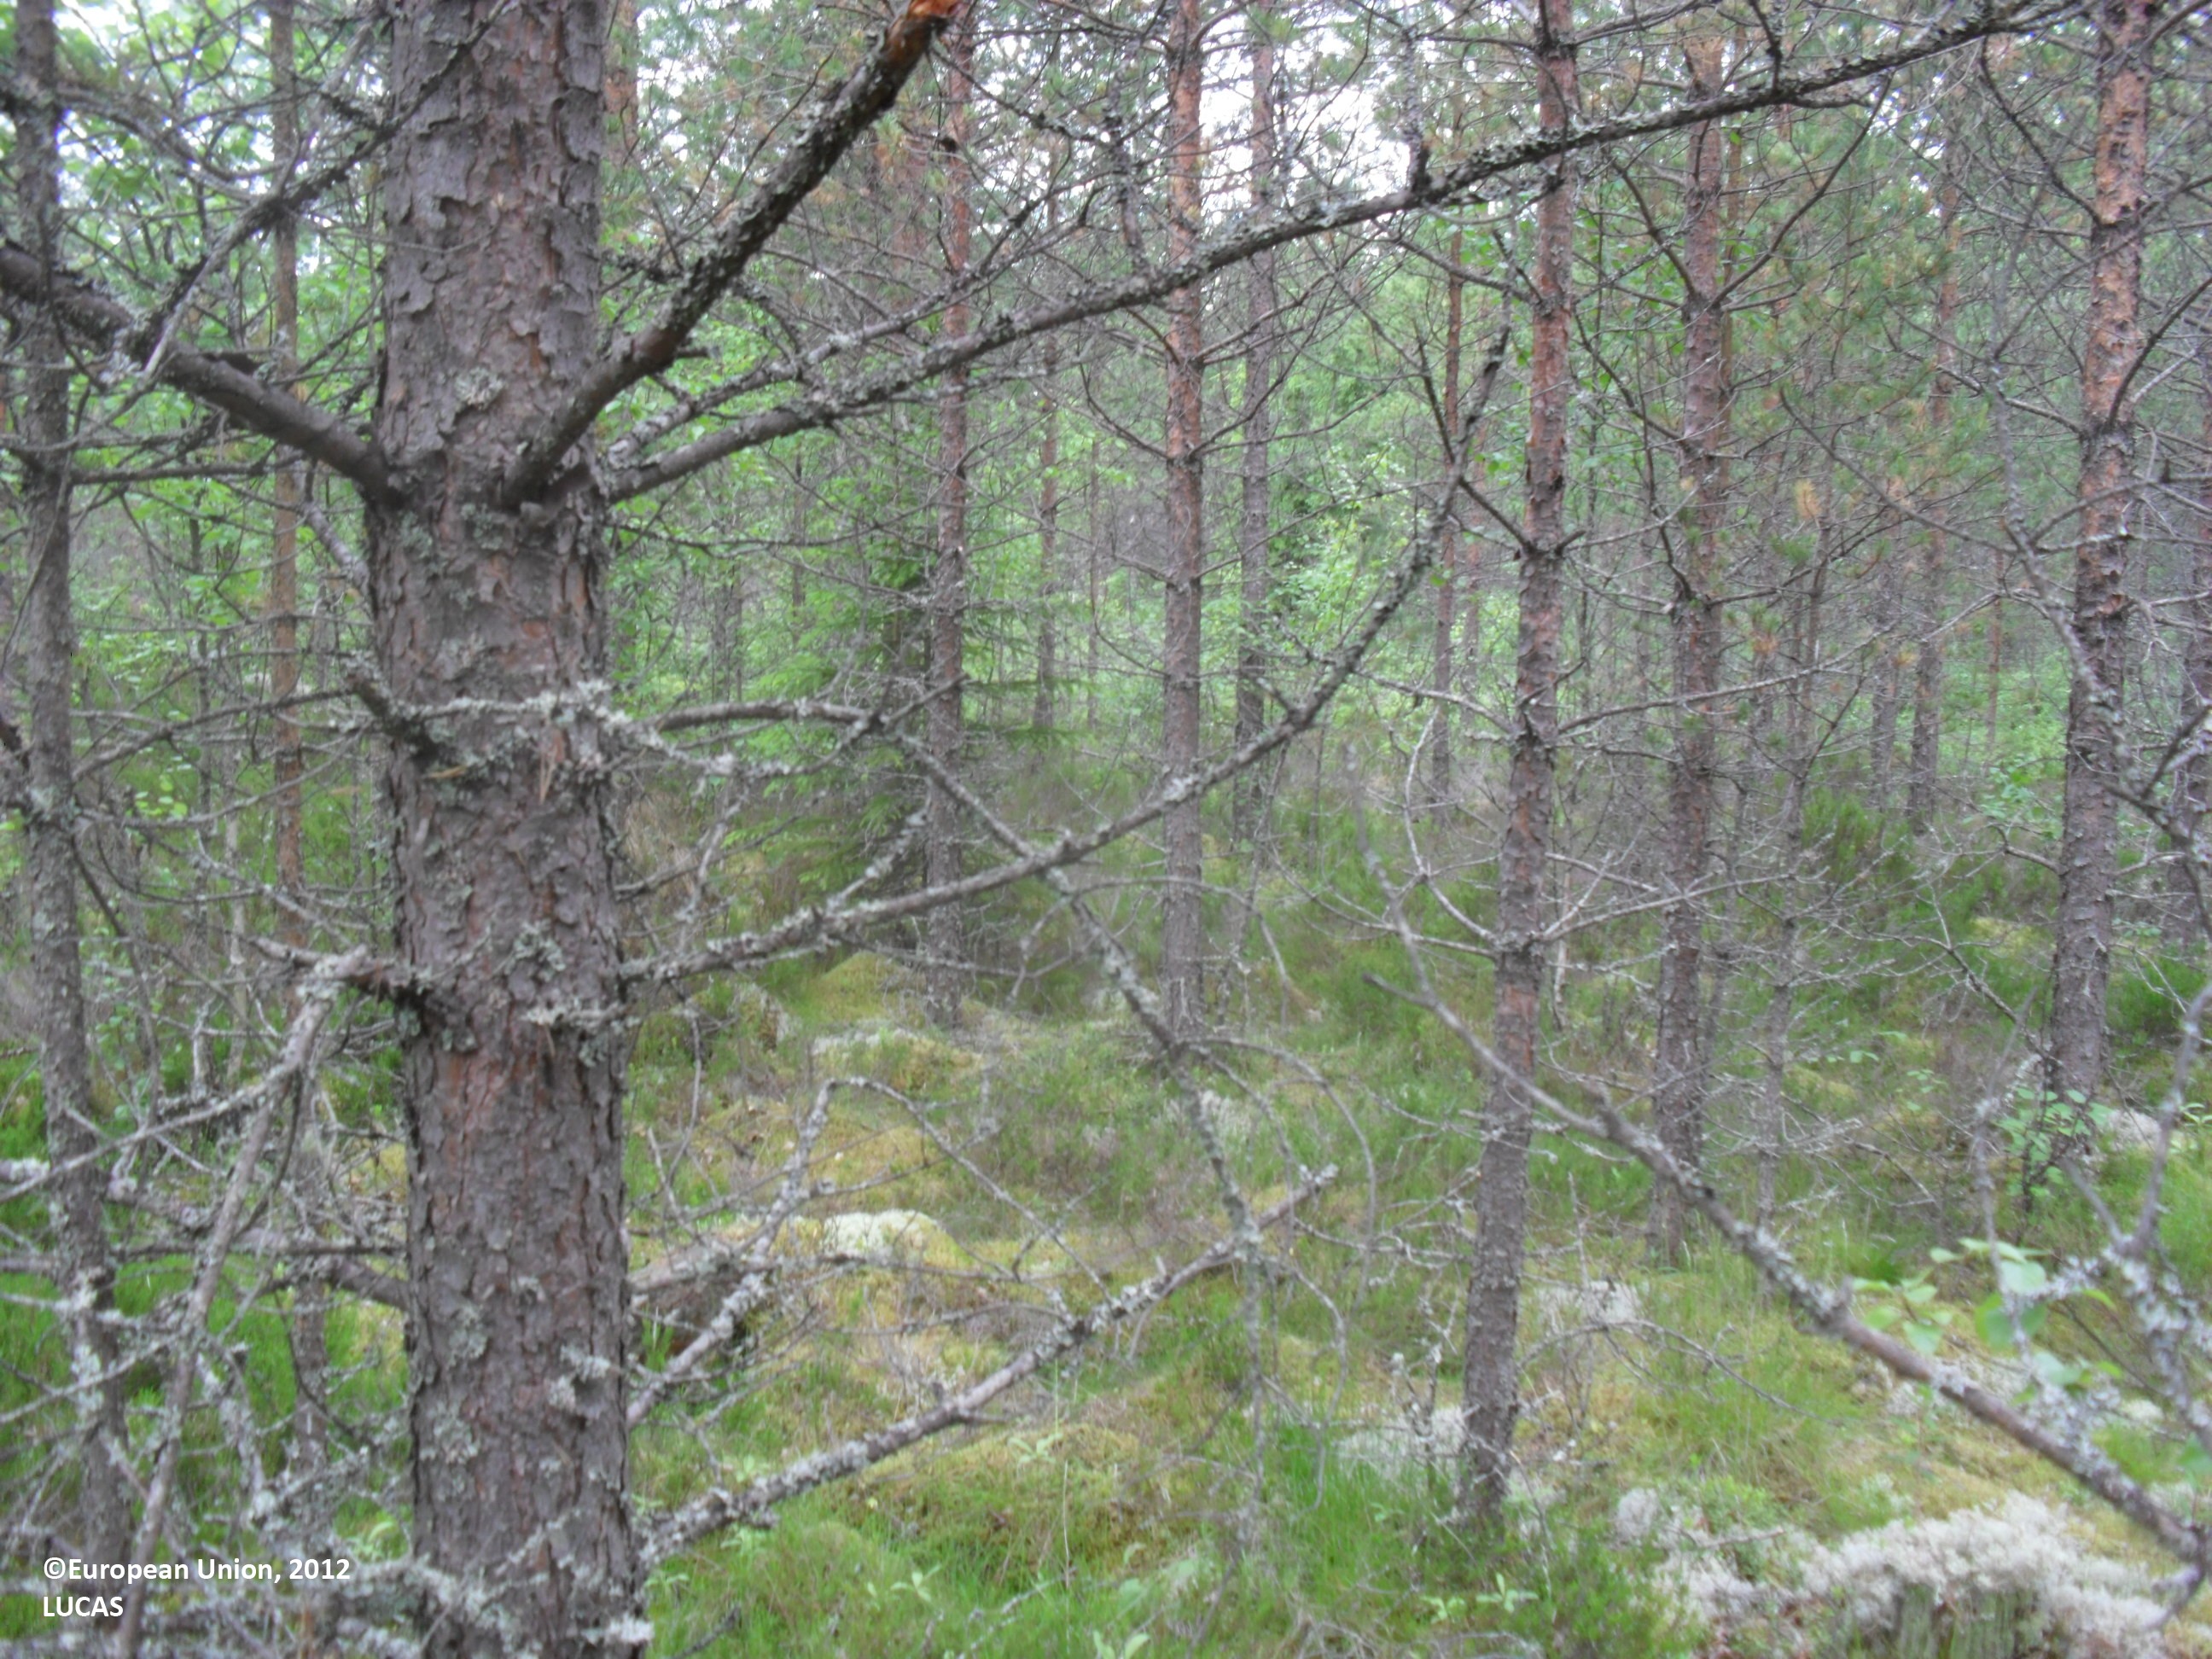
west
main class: Woodland
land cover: Pine dominated coniferous woodland
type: boreal forest
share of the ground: 50 - 75 %
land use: Forestry
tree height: > 5 m
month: June
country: FI
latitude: 62.9099
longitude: 23.5913
